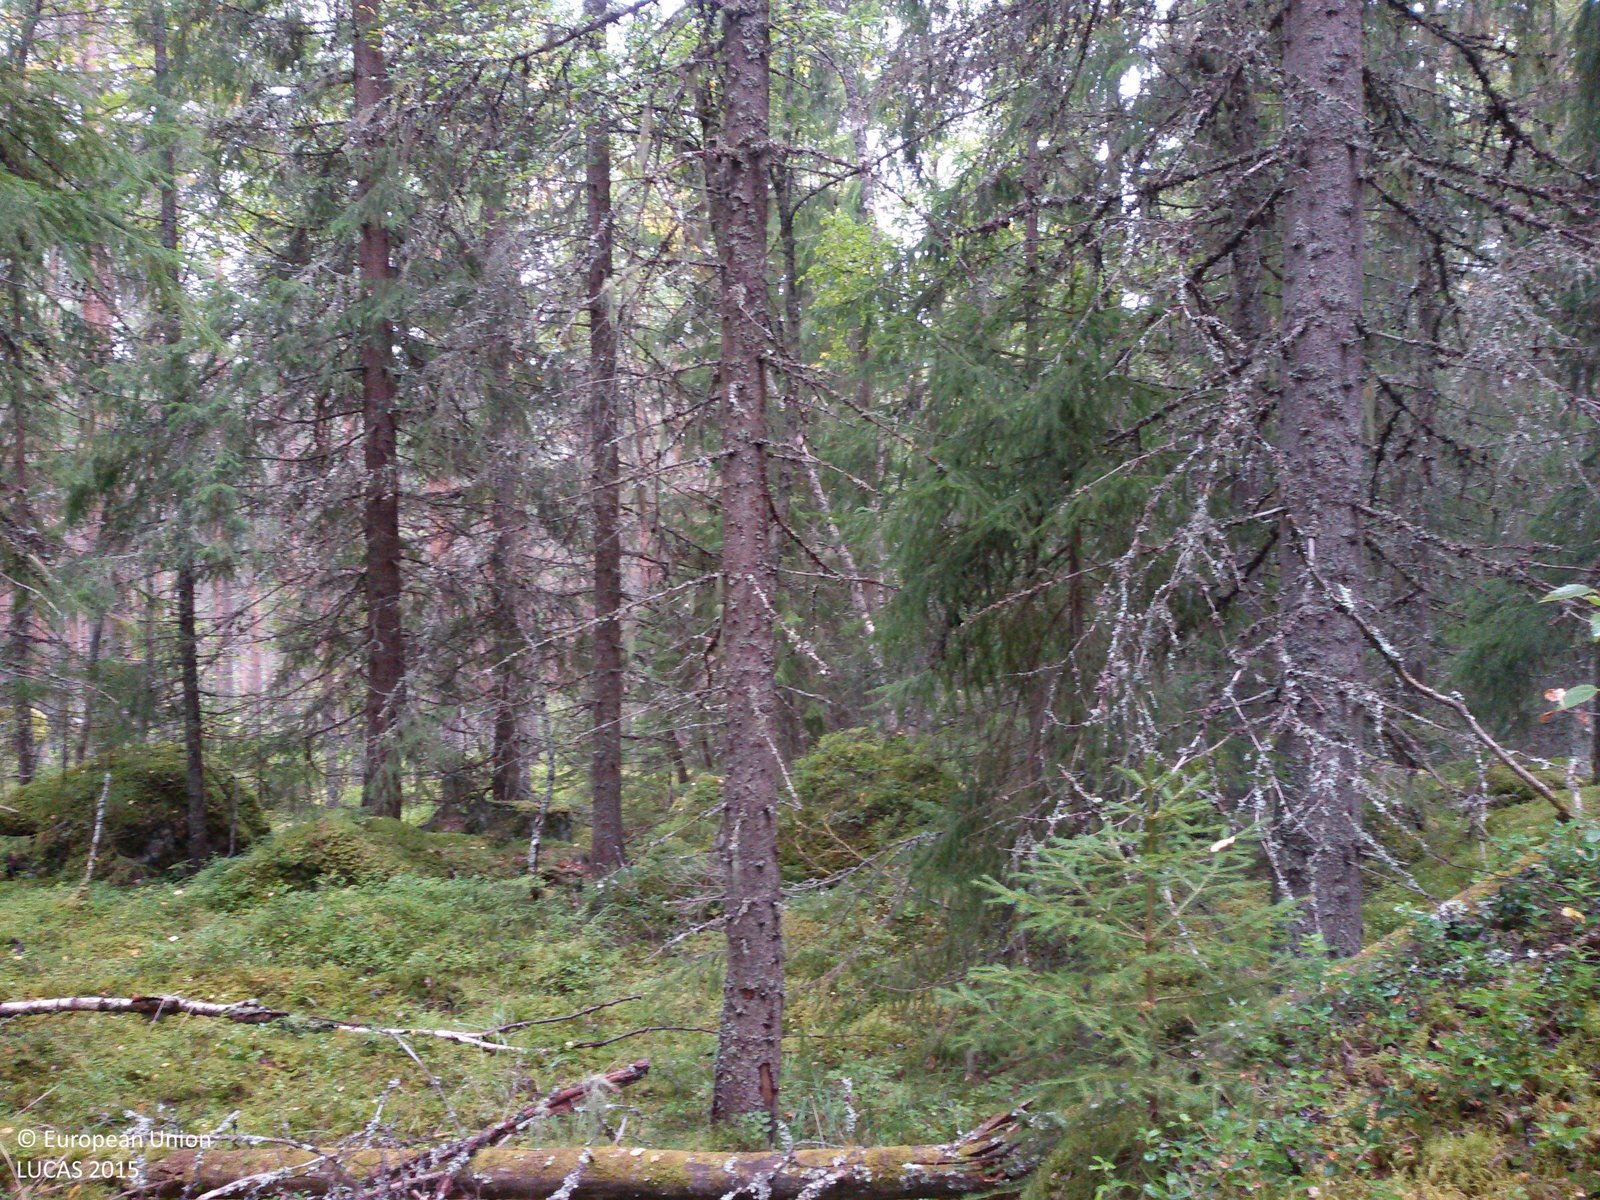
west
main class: Woodland
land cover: Spruce dominated coniferous woodland
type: boreal forest
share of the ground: > 75 %
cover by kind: coniferous forest trees 75 %, lichens and mosses 15 %, shrubs 10 %
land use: Forestry
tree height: > 5 m
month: September
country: SE
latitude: 60.7839
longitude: 15.3313
